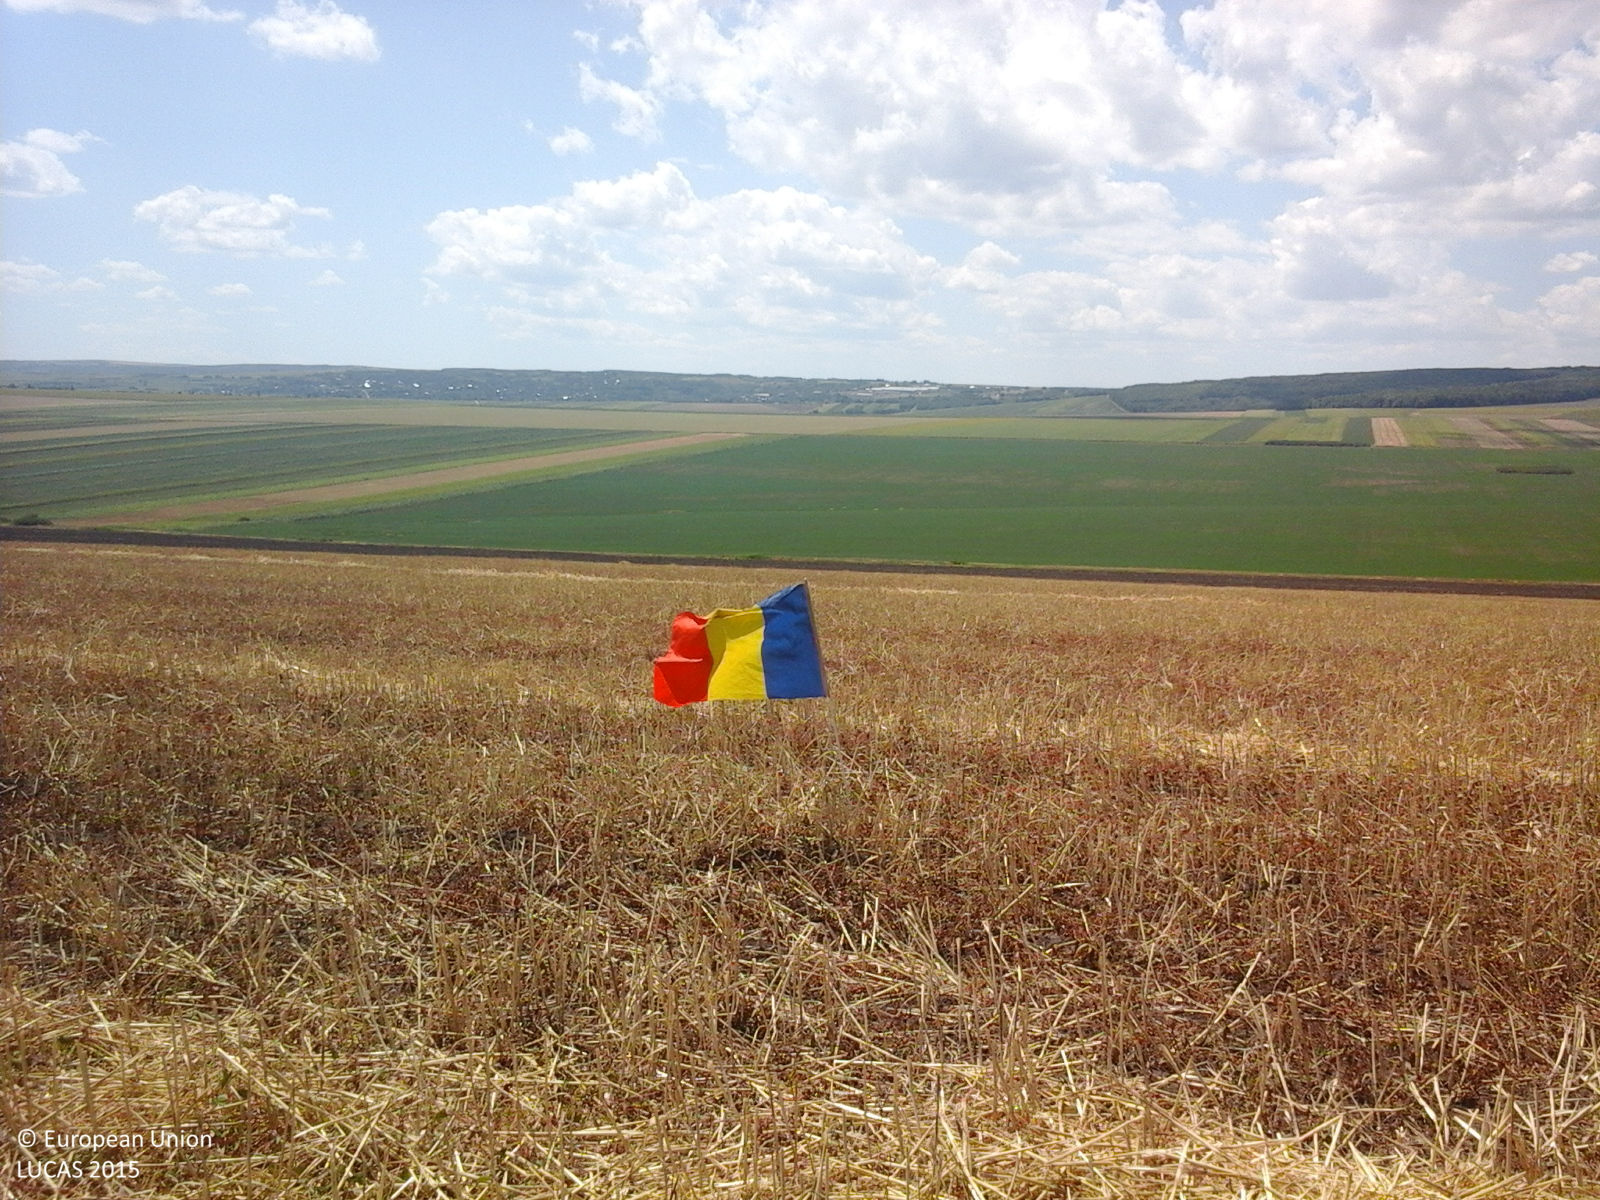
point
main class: Cropland
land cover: Common wheat
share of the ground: > 75 %
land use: Agriculture (excluding fallow land and kitchen gardens)
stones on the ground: < 10 %
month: July
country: RO
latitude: 46.4051
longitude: 27.9309
